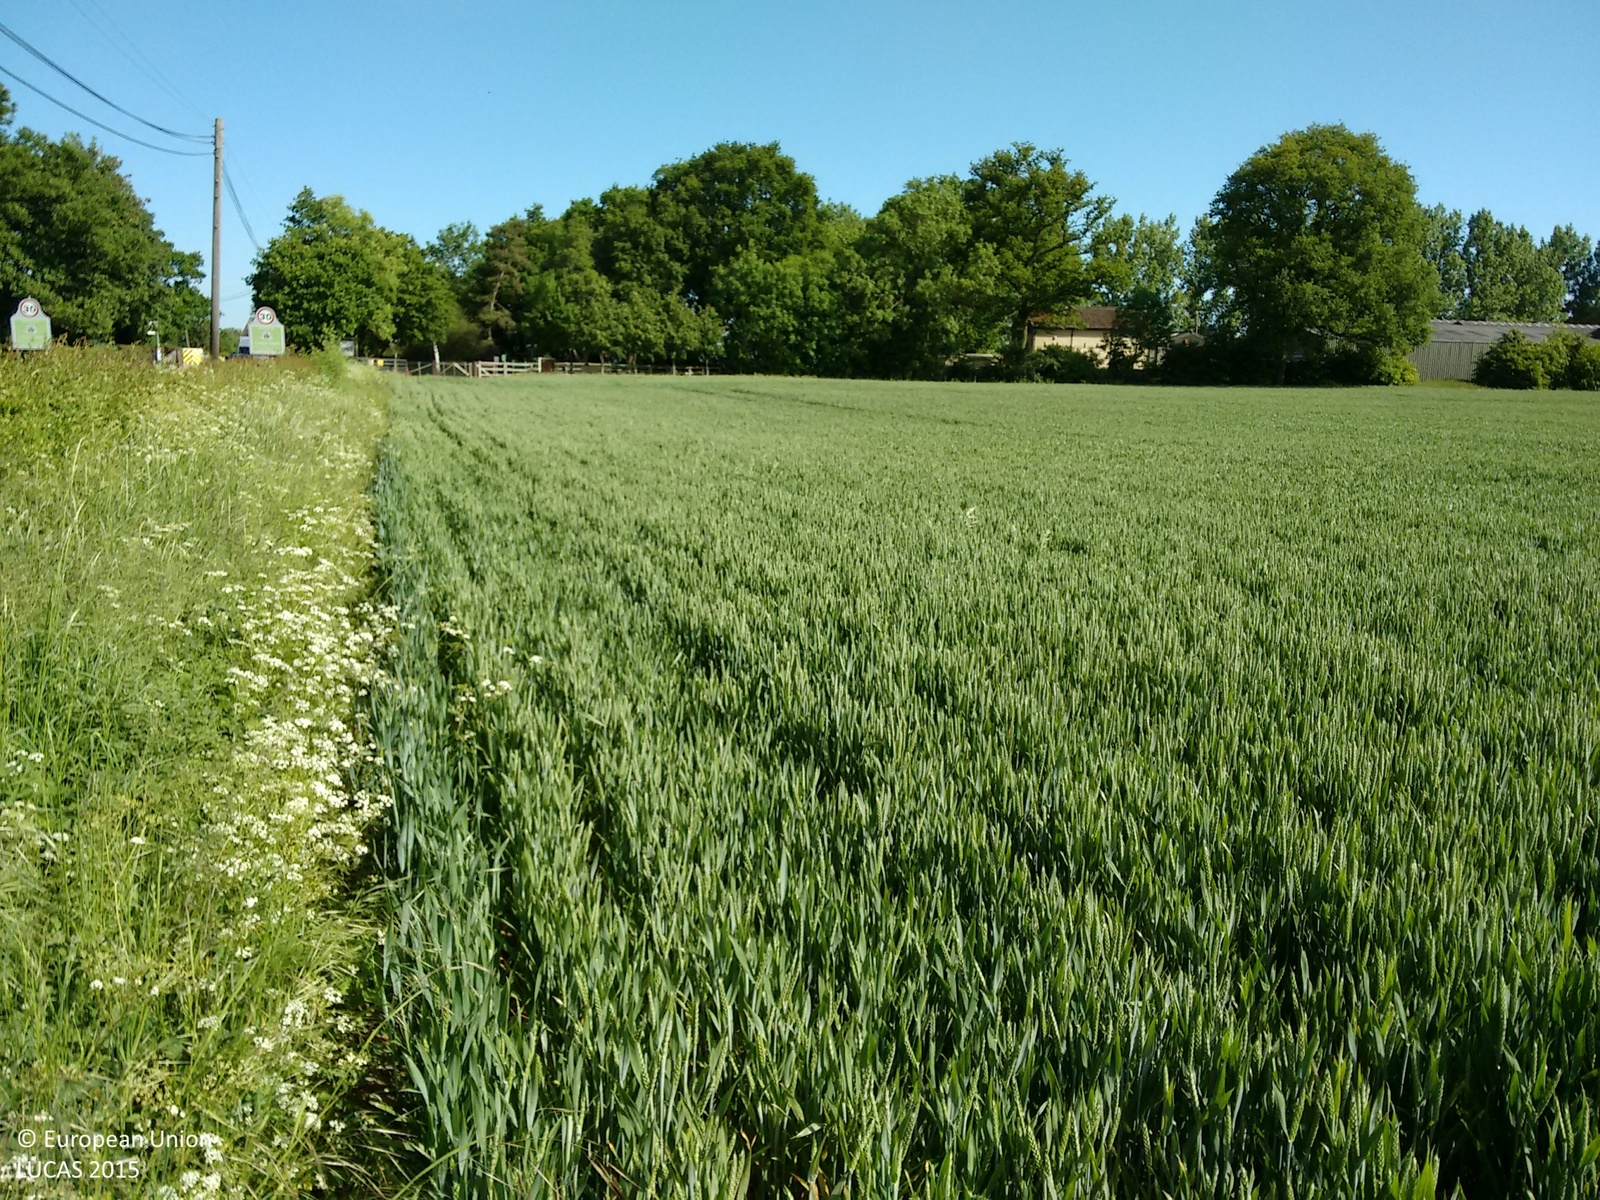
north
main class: Cropland
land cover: Common wheat
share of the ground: > 75 %
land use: Agriculture (excluding fallow land and kitchen gardens)
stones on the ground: < 10 %
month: June
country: GB
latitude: 51.7338
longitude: -0.2438
